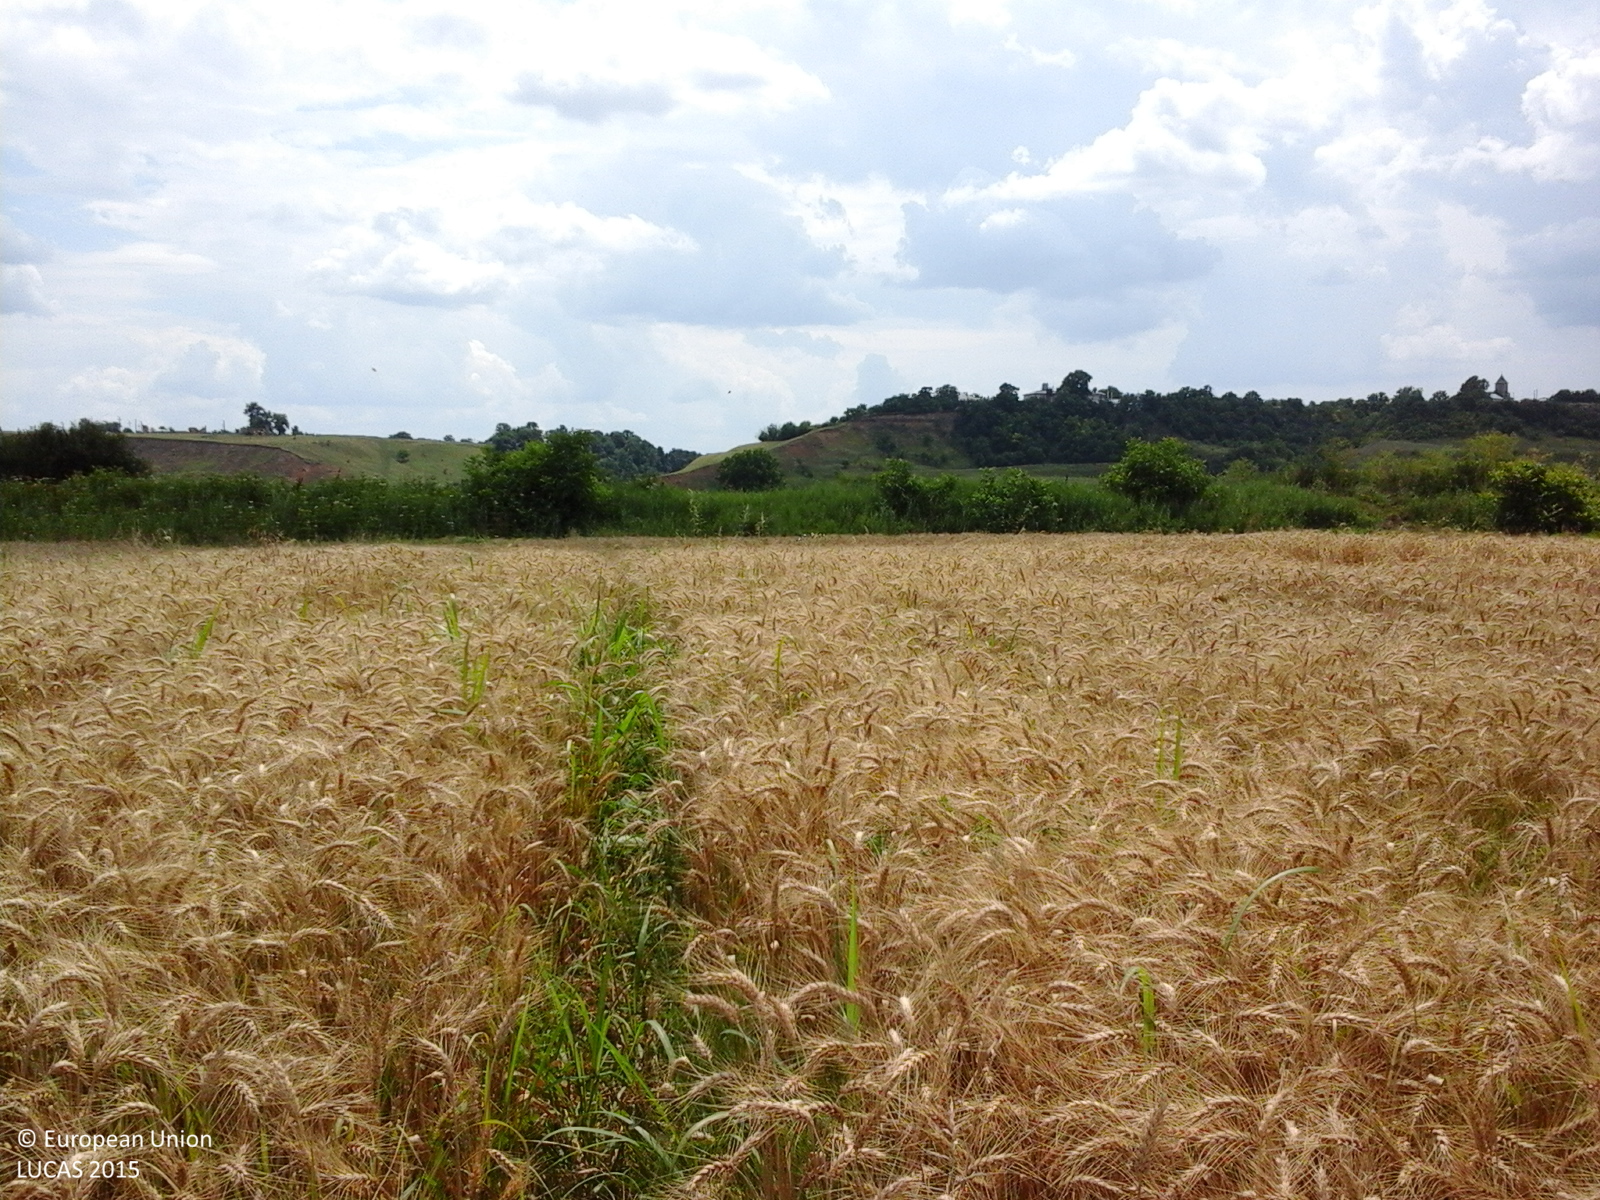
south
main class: Cropland
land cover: Common wheat
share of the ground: > 75 %
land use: Agriculture (excluding fallow land and kitchen gardens)
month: June
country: RO
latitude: 44.1791
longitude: 26.2547
